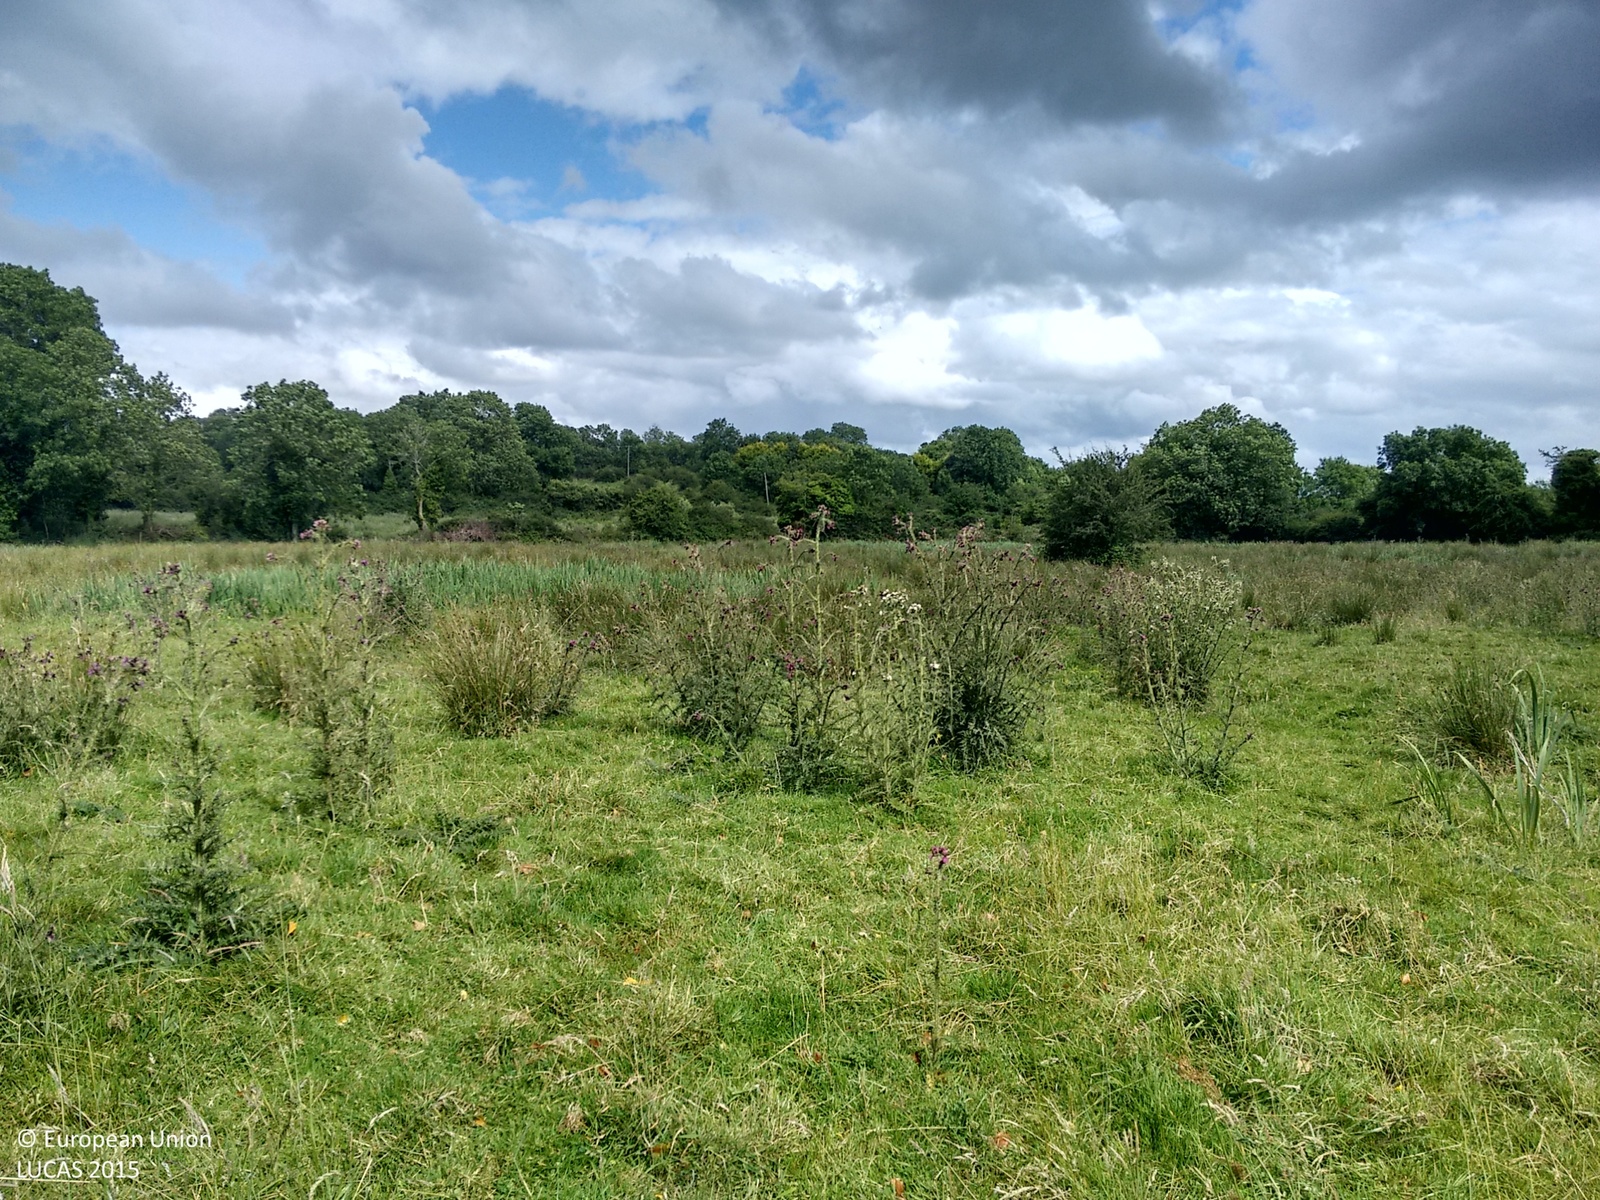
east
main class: Grassland
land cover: Grassland without tree/shrub cover
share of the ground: > 75 %
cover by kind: herbaceous plants 95 %, shrubs 5 %
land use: Agriculture (excluding fallow land and kitchen gardens)
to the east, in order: Grassland without tree/shrub cover; Managed hedges; Rivers and streams; Grassland without tree/shrub cover; Managed hedges; Electric lines; Grass margins; Paved roads, cycling and walking lanes; Grass margins; Managed hedges; Grassland without tree/shrub cover; Electric lines; Grassland without tree/shrub cover
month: July
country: IE
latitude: 53.6110
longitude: -7.7135
